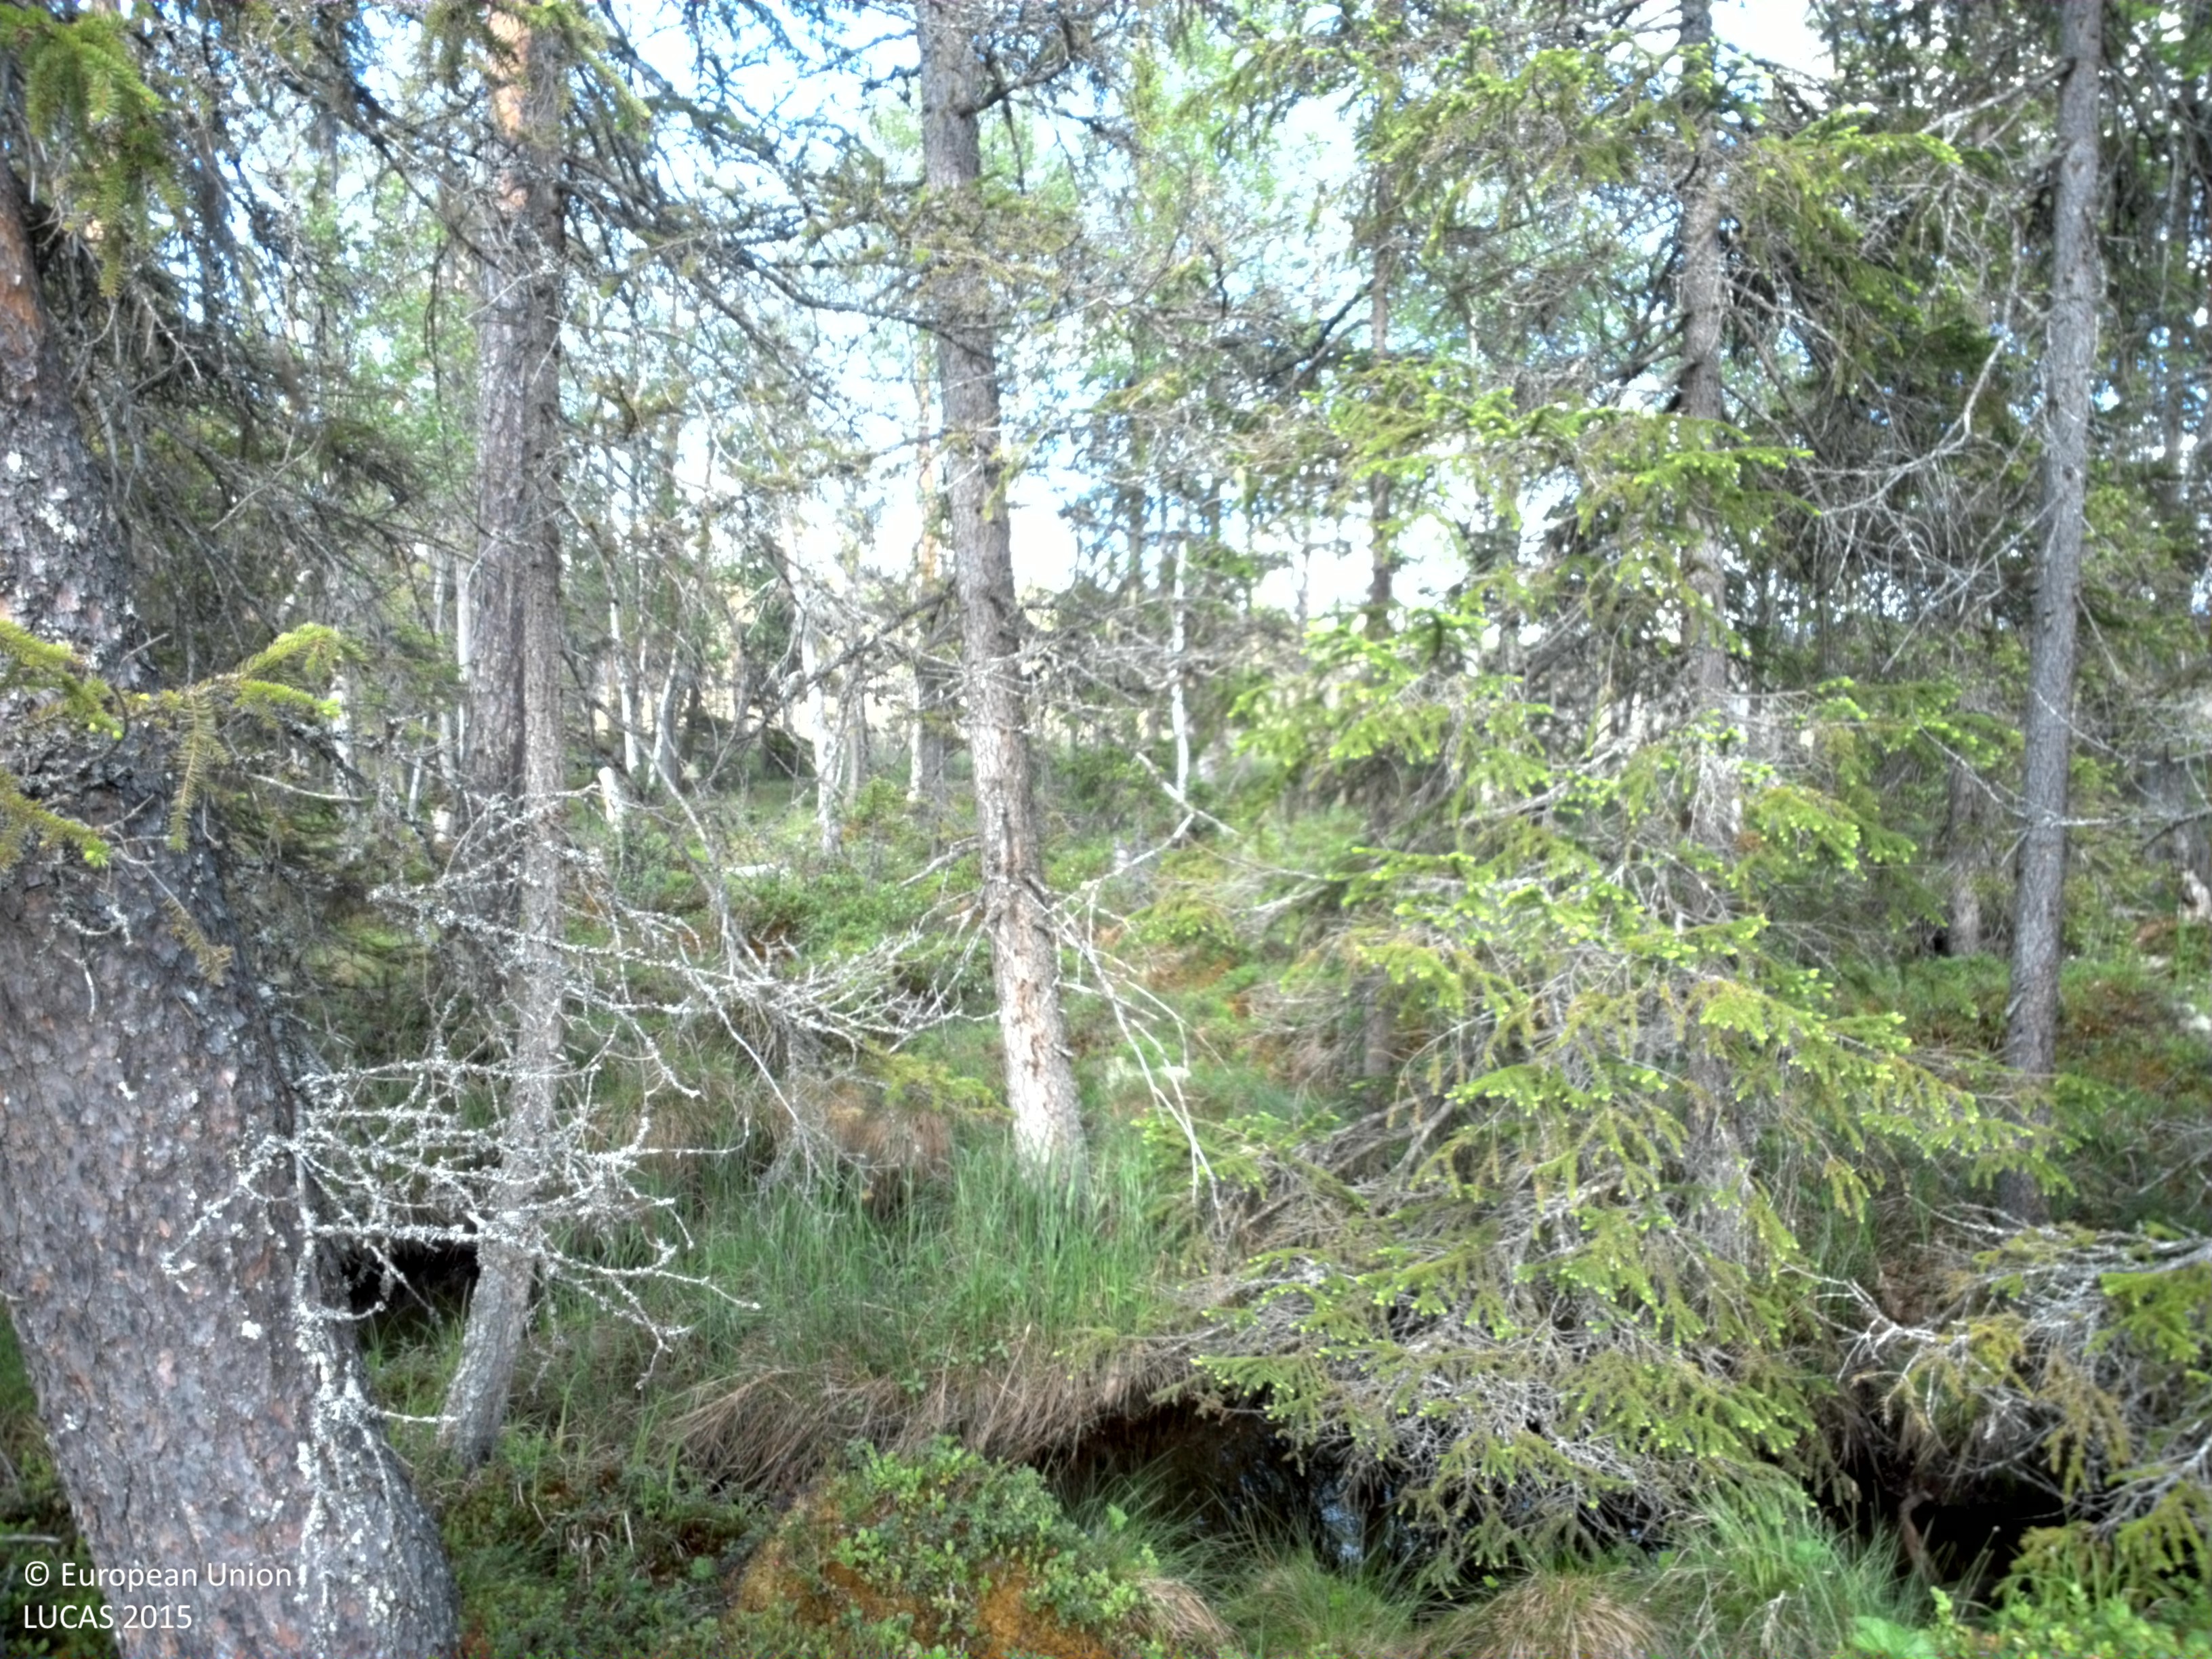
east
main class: Woodland
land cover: Other coniferous woodland
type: boreal forest
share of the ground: 25 - 50 %
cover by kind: shrubs 40 %, coniferous forest trees 25 %, lichens and mosses 20 %, herbaceous plants 15 %
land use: Forestry
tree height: > 5 m
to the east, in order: Other coniferous woodland; Pine dominated coniferous woodland; Peatbogs; Shrubland with sparse tree cover; Pine dominated coniferous woodland
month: June
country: SE
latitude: 61.8512
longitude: 12.5546
